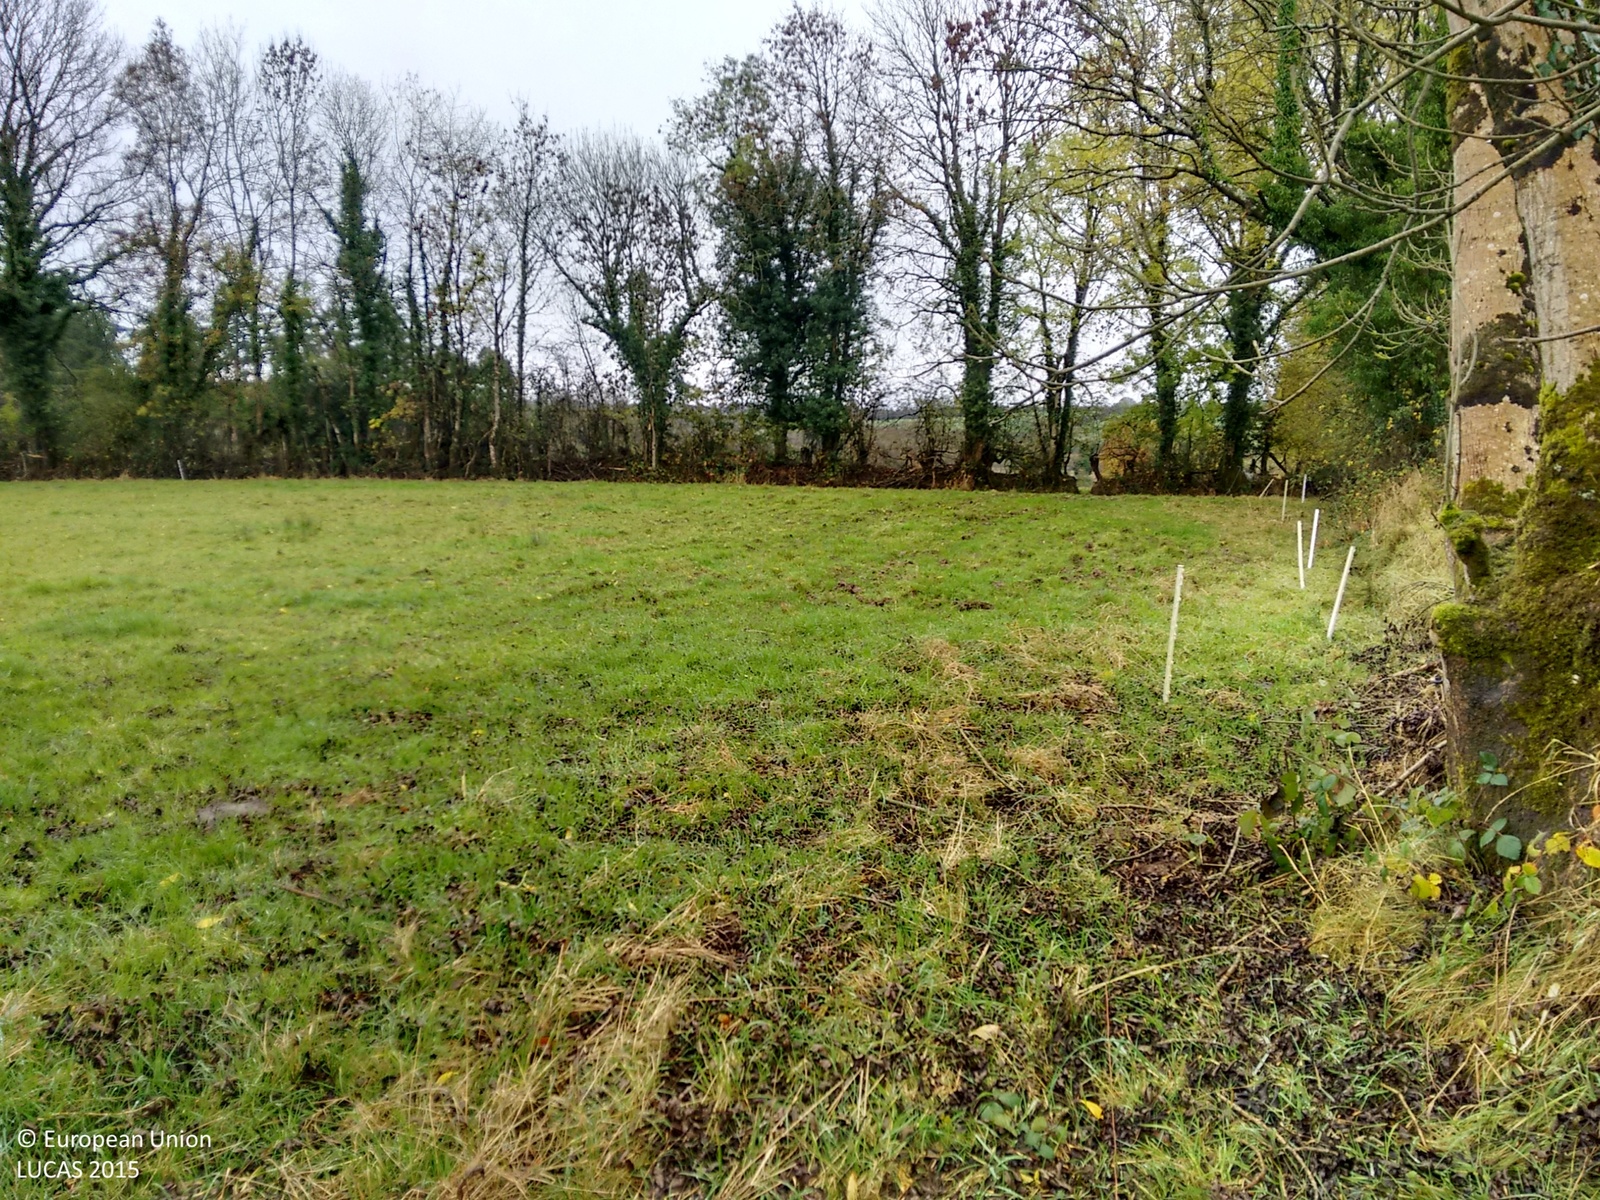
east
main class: Grassland
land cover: Grassland without tree/shrub cover
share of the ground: > 75 %
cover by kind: herbaceous plants 100 %
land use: Agriculture (excluding fallow land and kitchen gardens)
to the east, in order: Grassland without tree/shrub cover; Ditches and canals; Abandoned hedges; Ditches and canals; Grassland without tree/shrub cover; Abandoned hedges; Grassland without tree/shrub cover
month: October
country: IE
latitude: 53.8487
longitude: -8.0995
